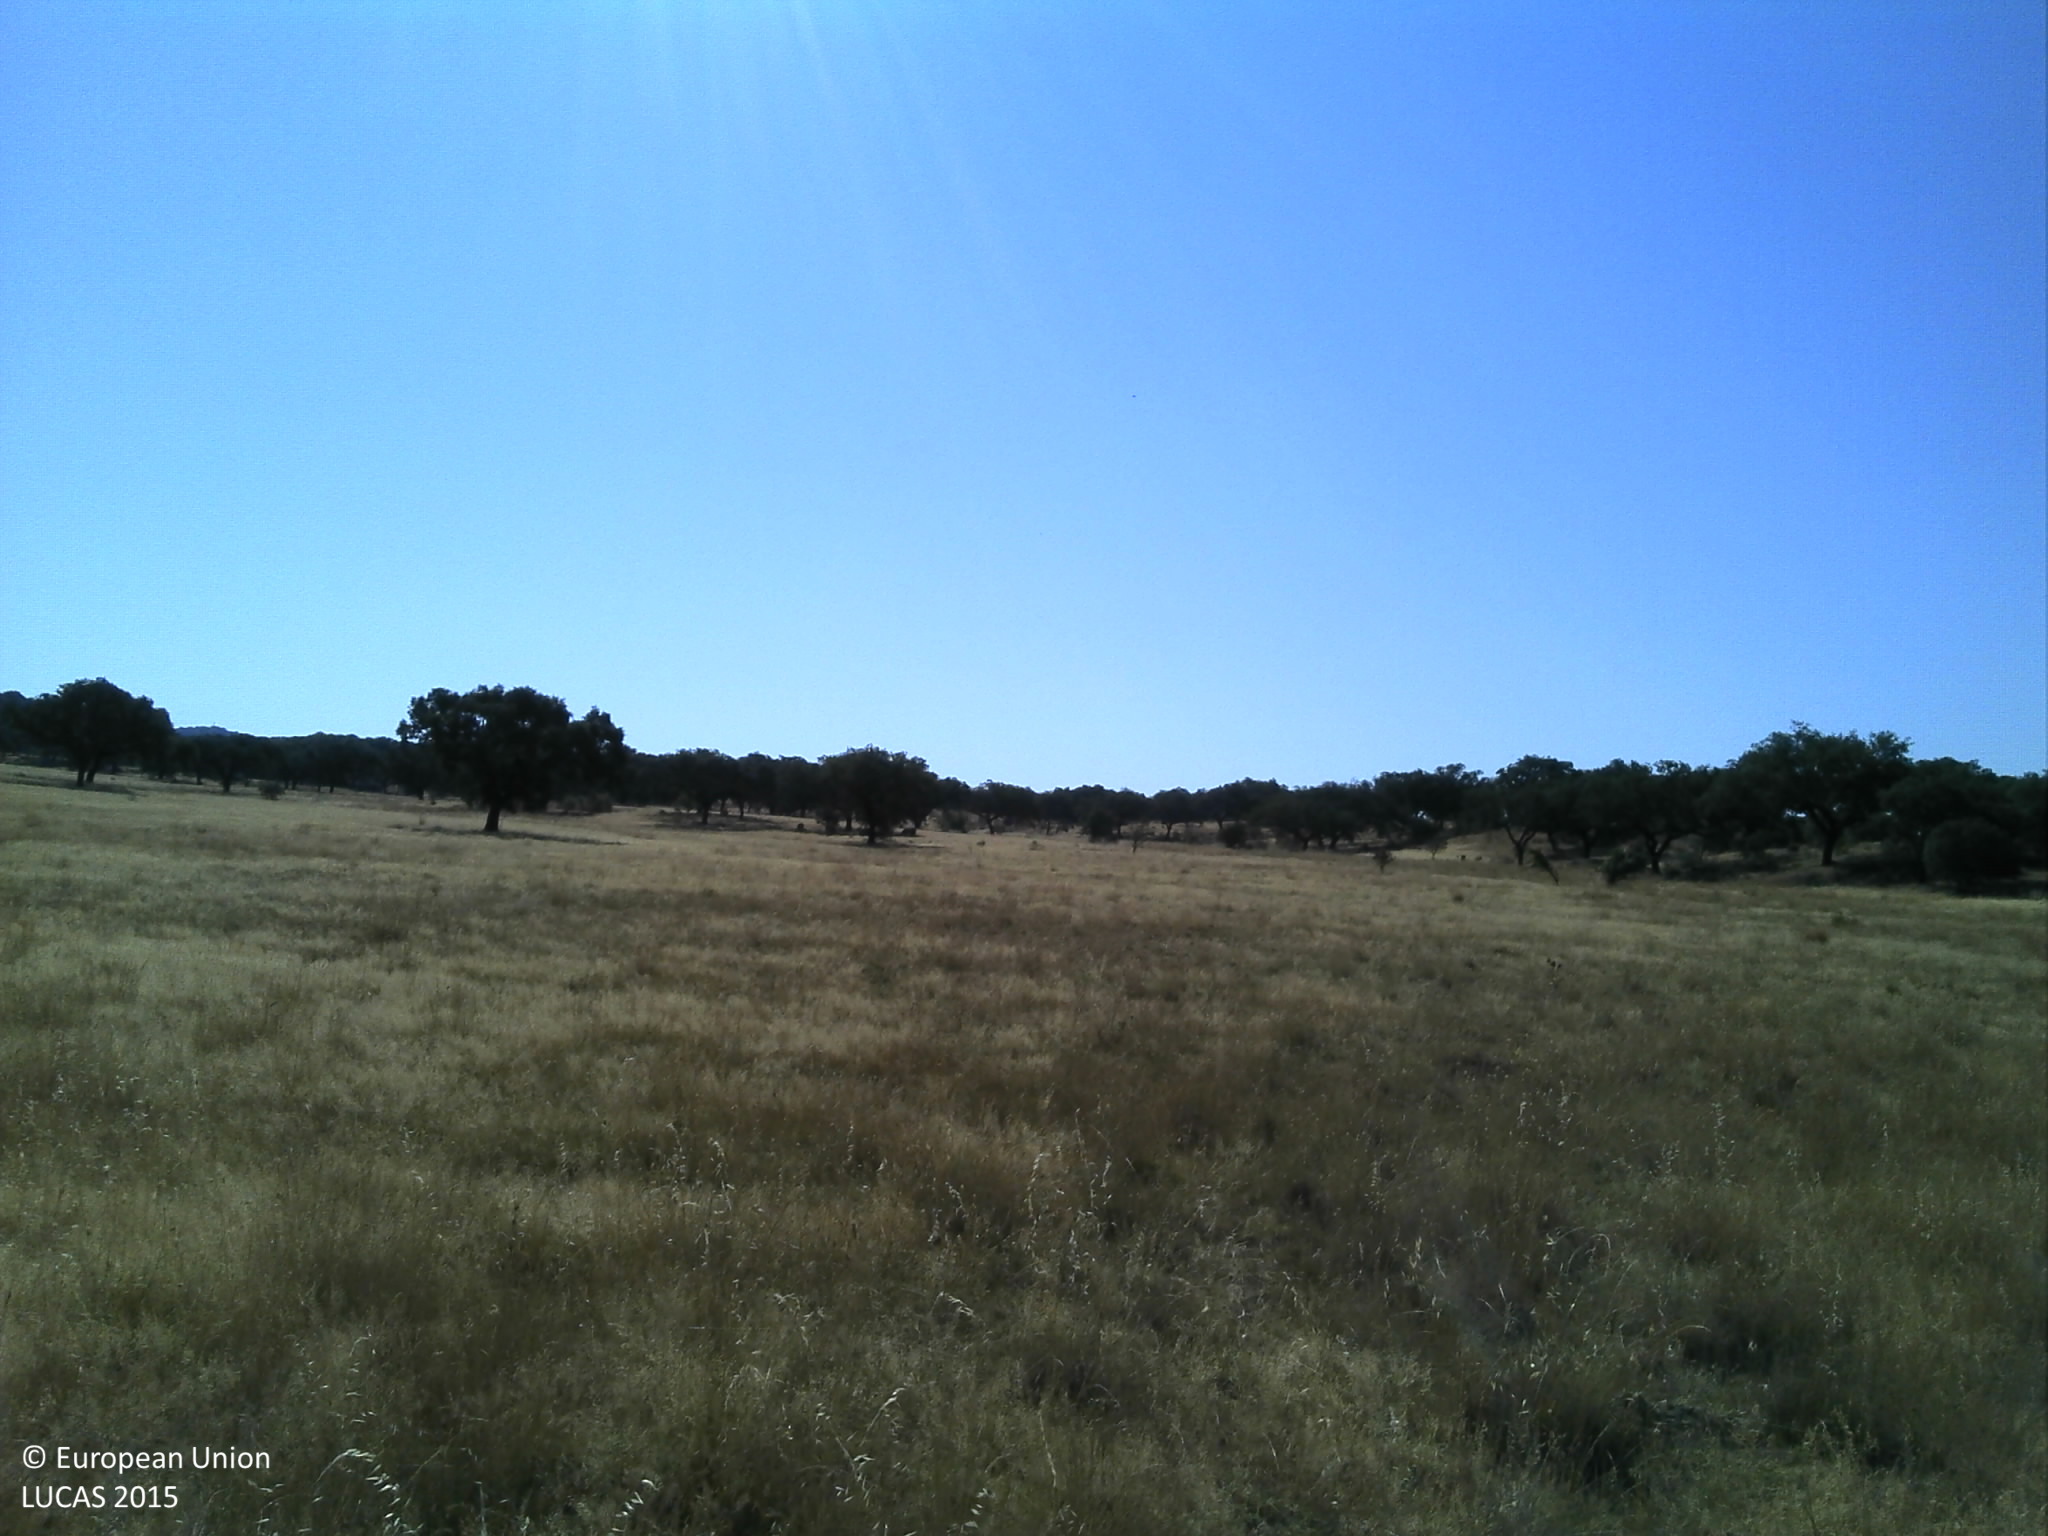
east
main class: Woodland
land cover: Broadleaved woodland
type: broadleaved evergreen forest
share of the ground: 10 - 25 %
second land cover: Grassland without tree/shrub cover
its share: 50 - 75 %
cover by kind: herbaceous plants 75 %, unconsolidated bare surface 15 %, broadleaved forest trees 10 %
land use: Forestry
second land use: Agriculture (excluding fallow land and kitchen gardens)
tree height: > 5 m
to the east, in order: Broadleaved woodland; Grassland without tree/shrub cover; Broadleaved woodland; Grassland without tree/shrub cover; Single bushes/trees; Grassland without tree/shrub cover; Broadleaved woodland
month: June
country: PT
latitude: 38.3161
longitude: -7.7706
